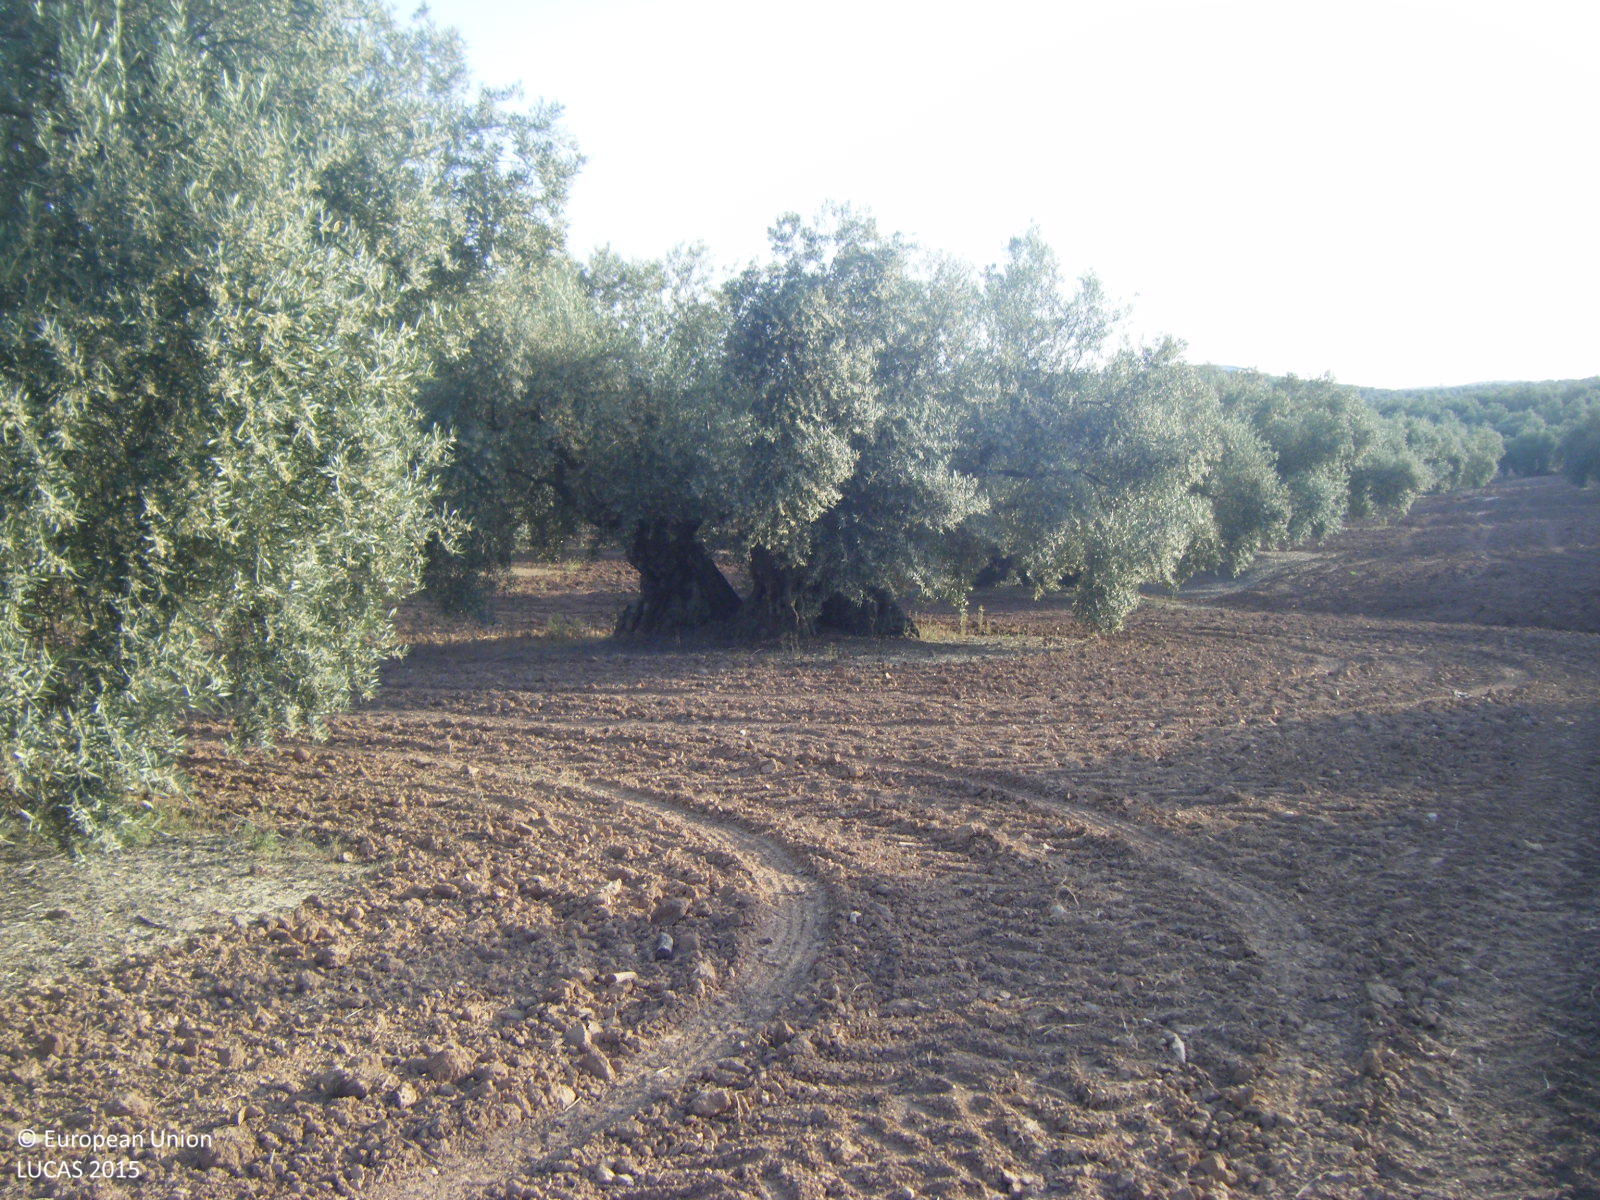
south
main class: Cropland
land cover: Olive groves
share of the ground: 25 - 50 %
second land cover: Other bare soil
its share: > 75 %
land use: Agriculture (excluding fallow land and kitchen gardens)
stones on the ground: < 10 %
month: May
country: ES
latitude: 37.3034
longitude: -4.5440
